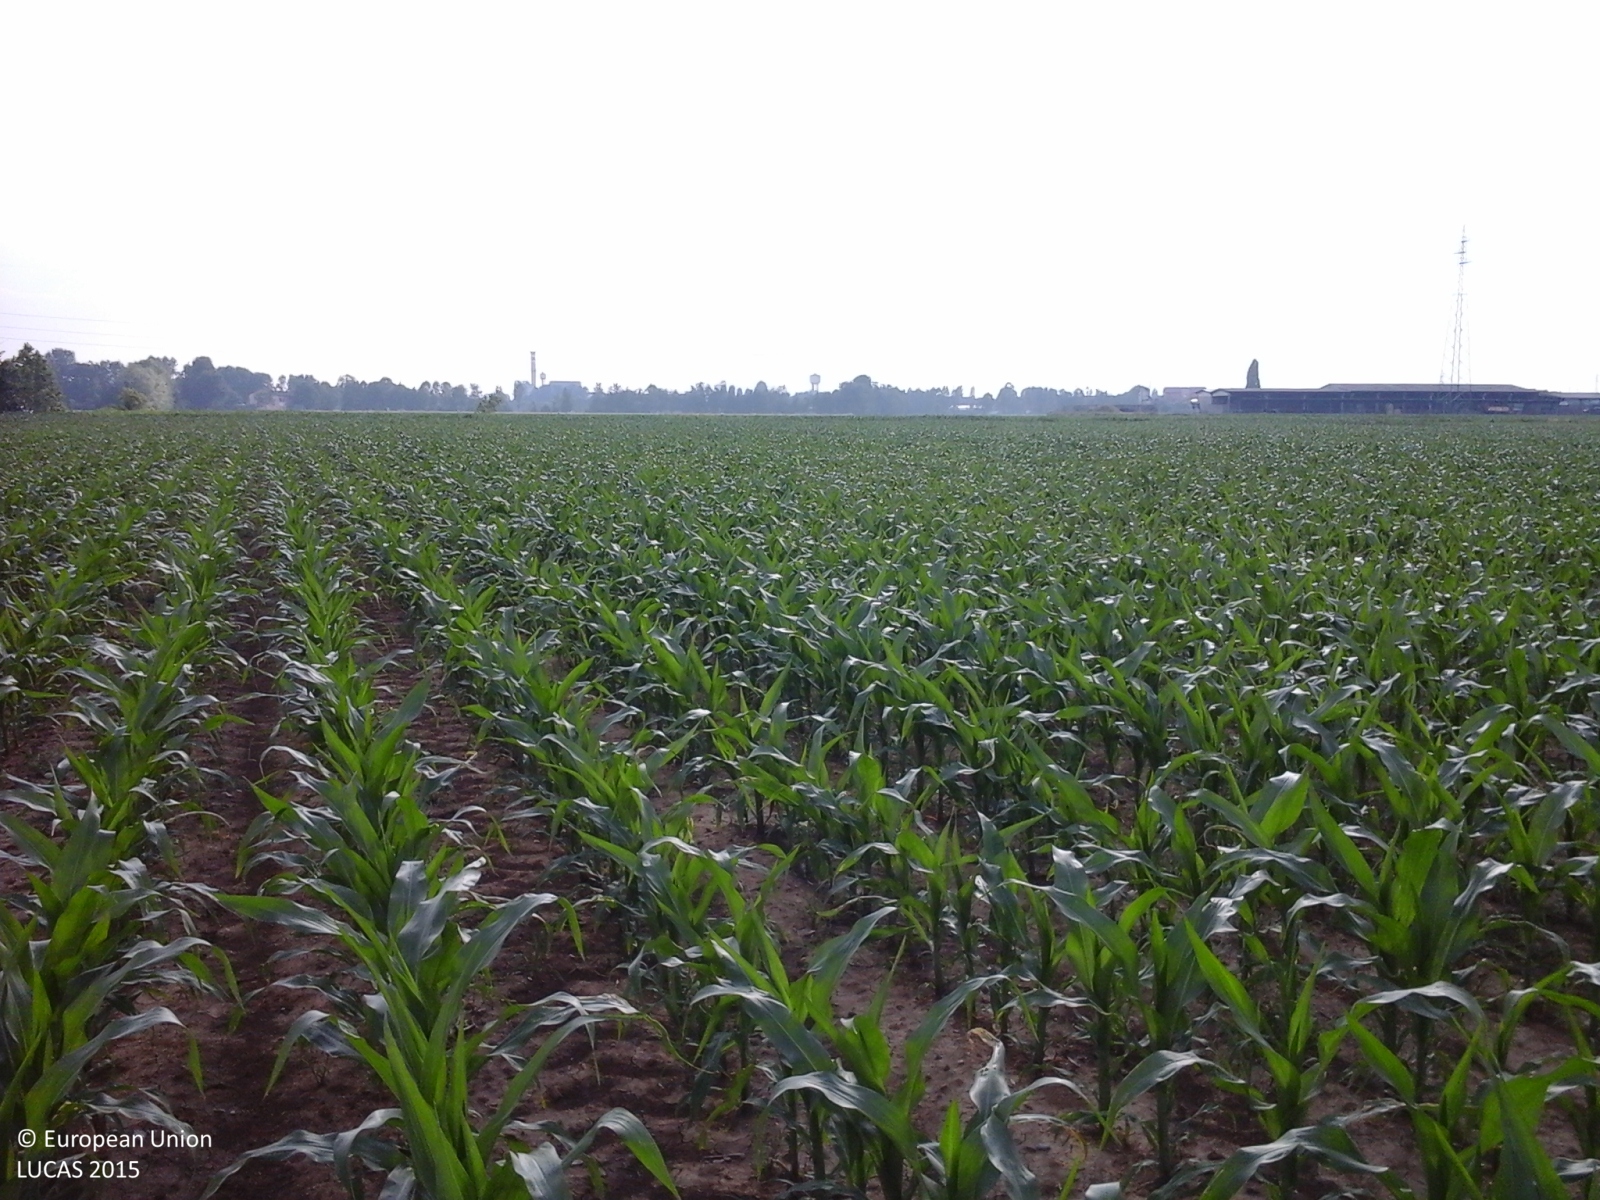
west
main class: Cropland
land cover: Maize
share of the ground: 25 - 50 %
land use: Agriculture (excluding fallow land and kitchen gardens)
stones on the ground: < 10 %
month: May
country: IT
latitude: 45.5219
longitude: 9.6549
